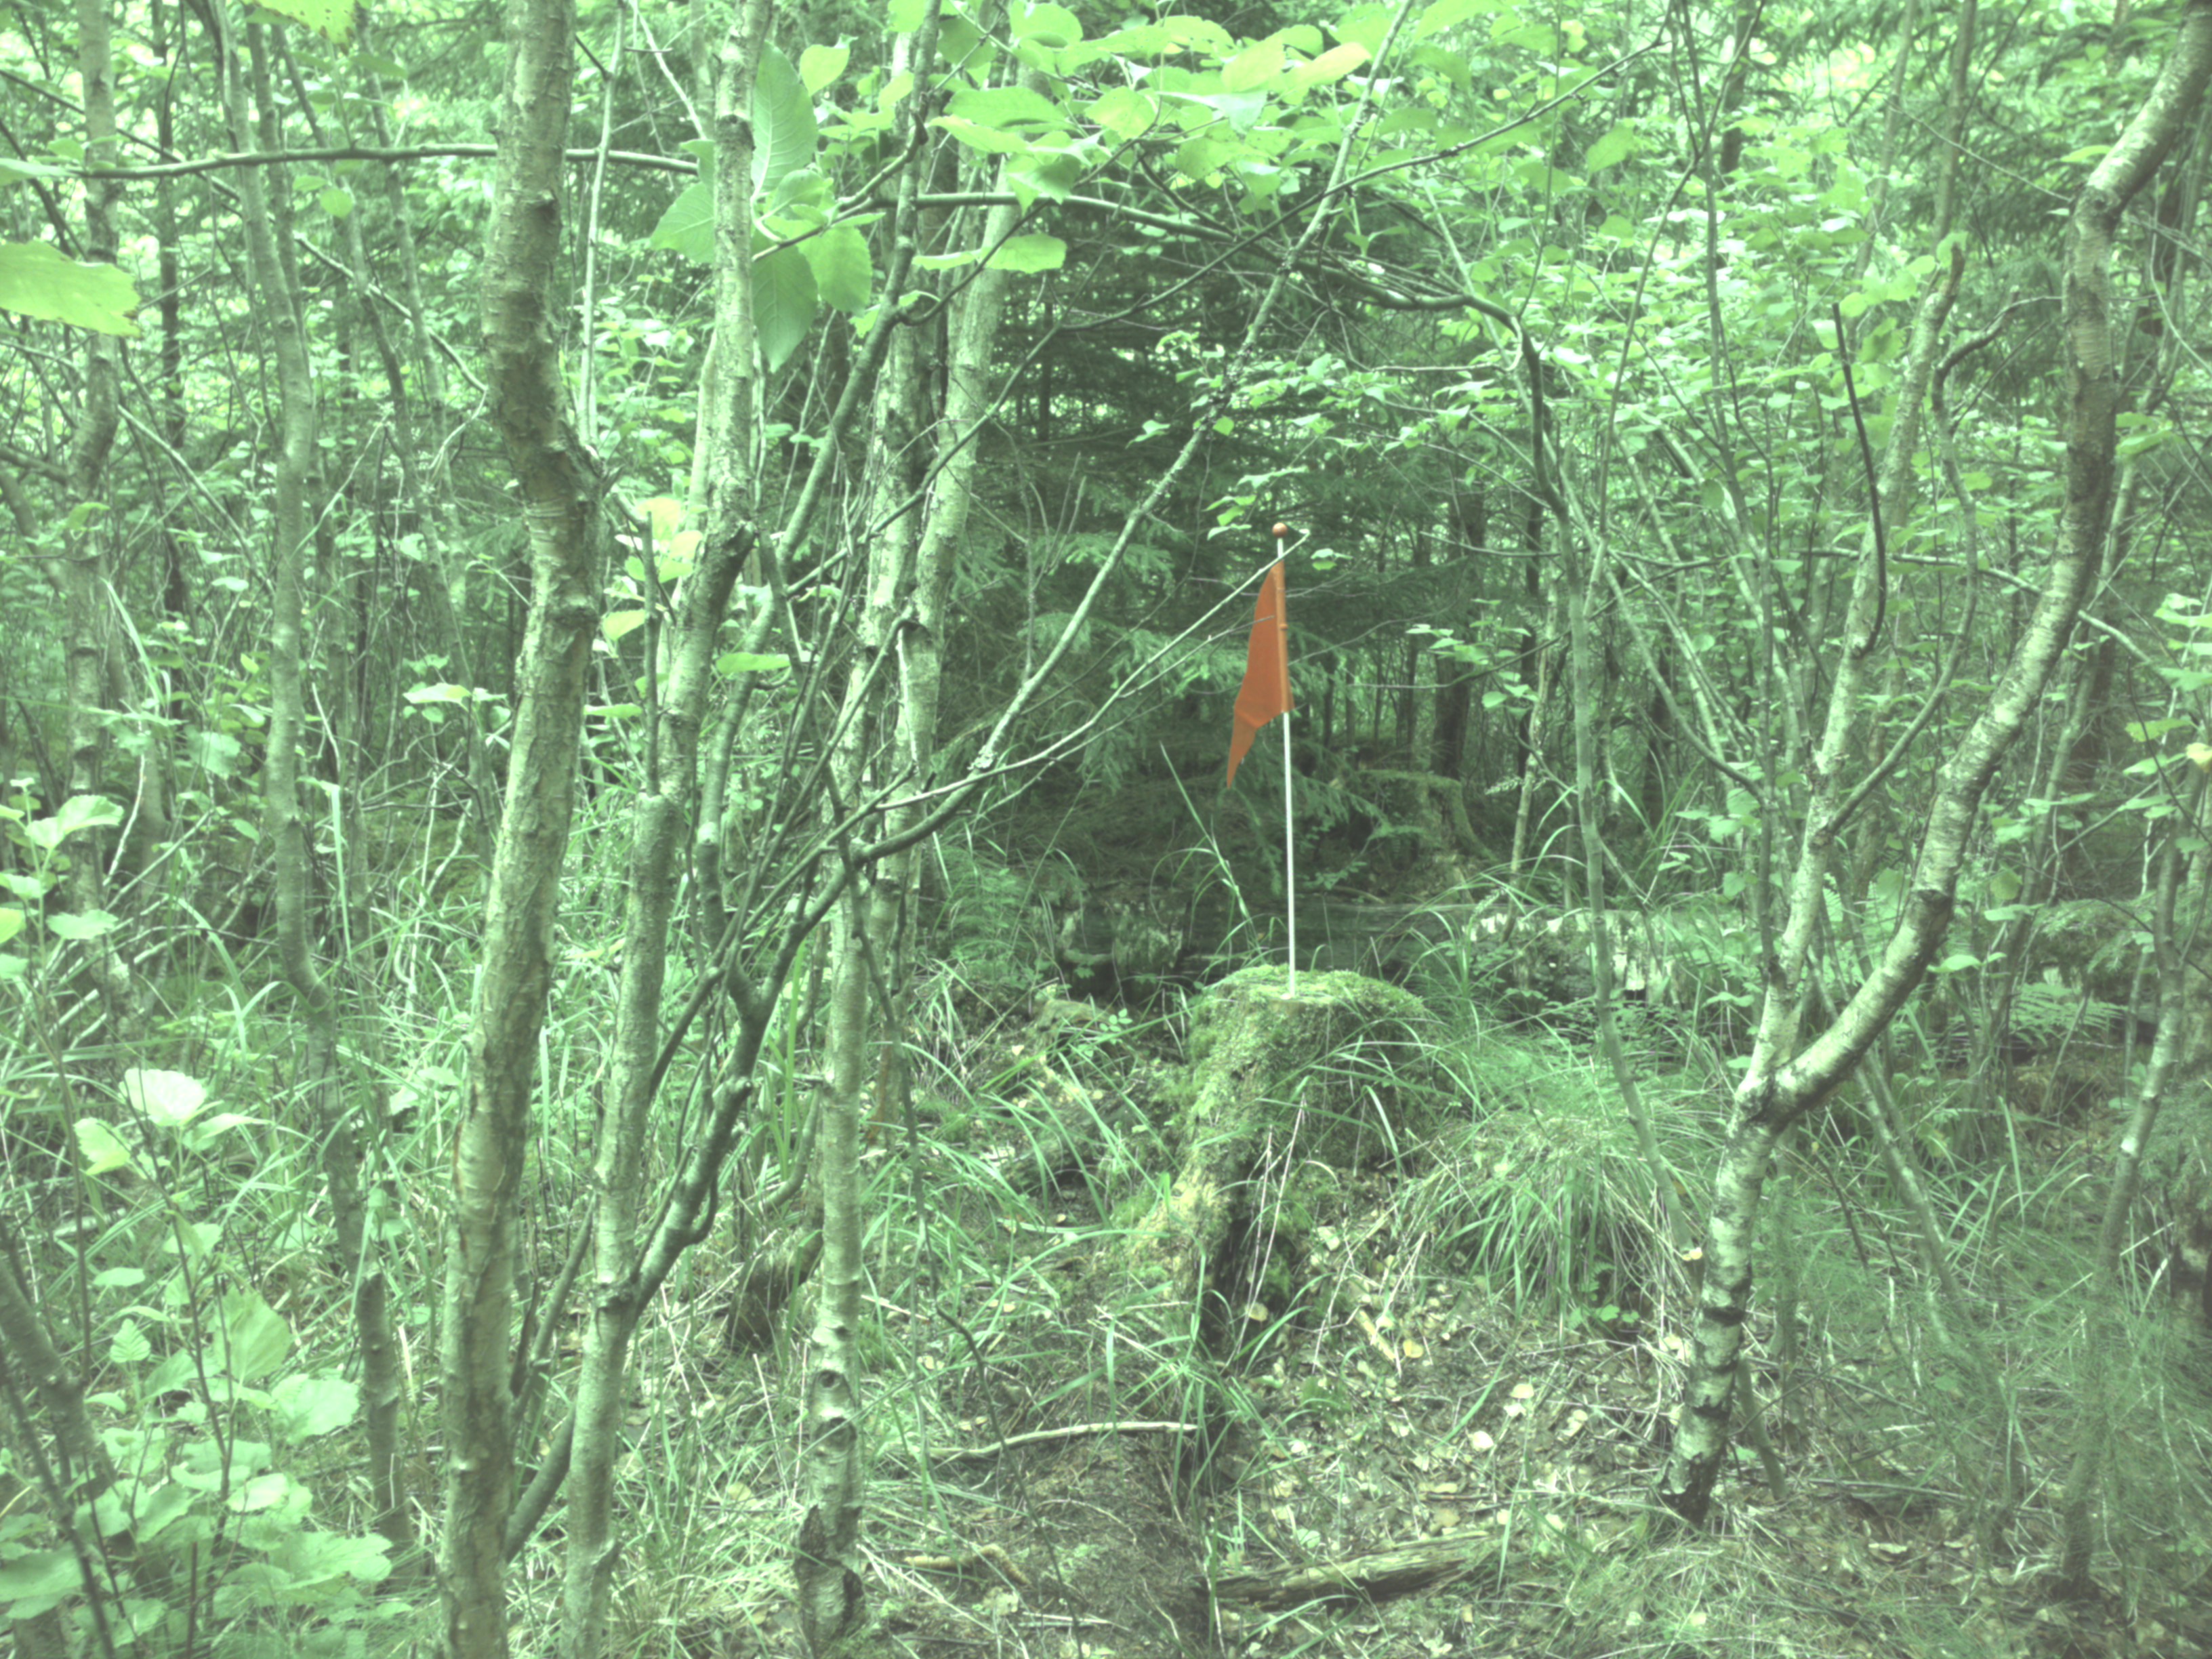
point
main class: Woodland
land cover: Spruce dominated mixed woodland
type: boreal forest
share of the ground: > 75 %
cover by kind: coniferous forest trees 50 %, broadleaved forest trees 40 %, herbaceous plants 5 %, lichens and mosses 5 %
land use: Forestry
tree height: > 5 m
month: July
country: SE
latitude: 59.1505
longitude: 18.4110
